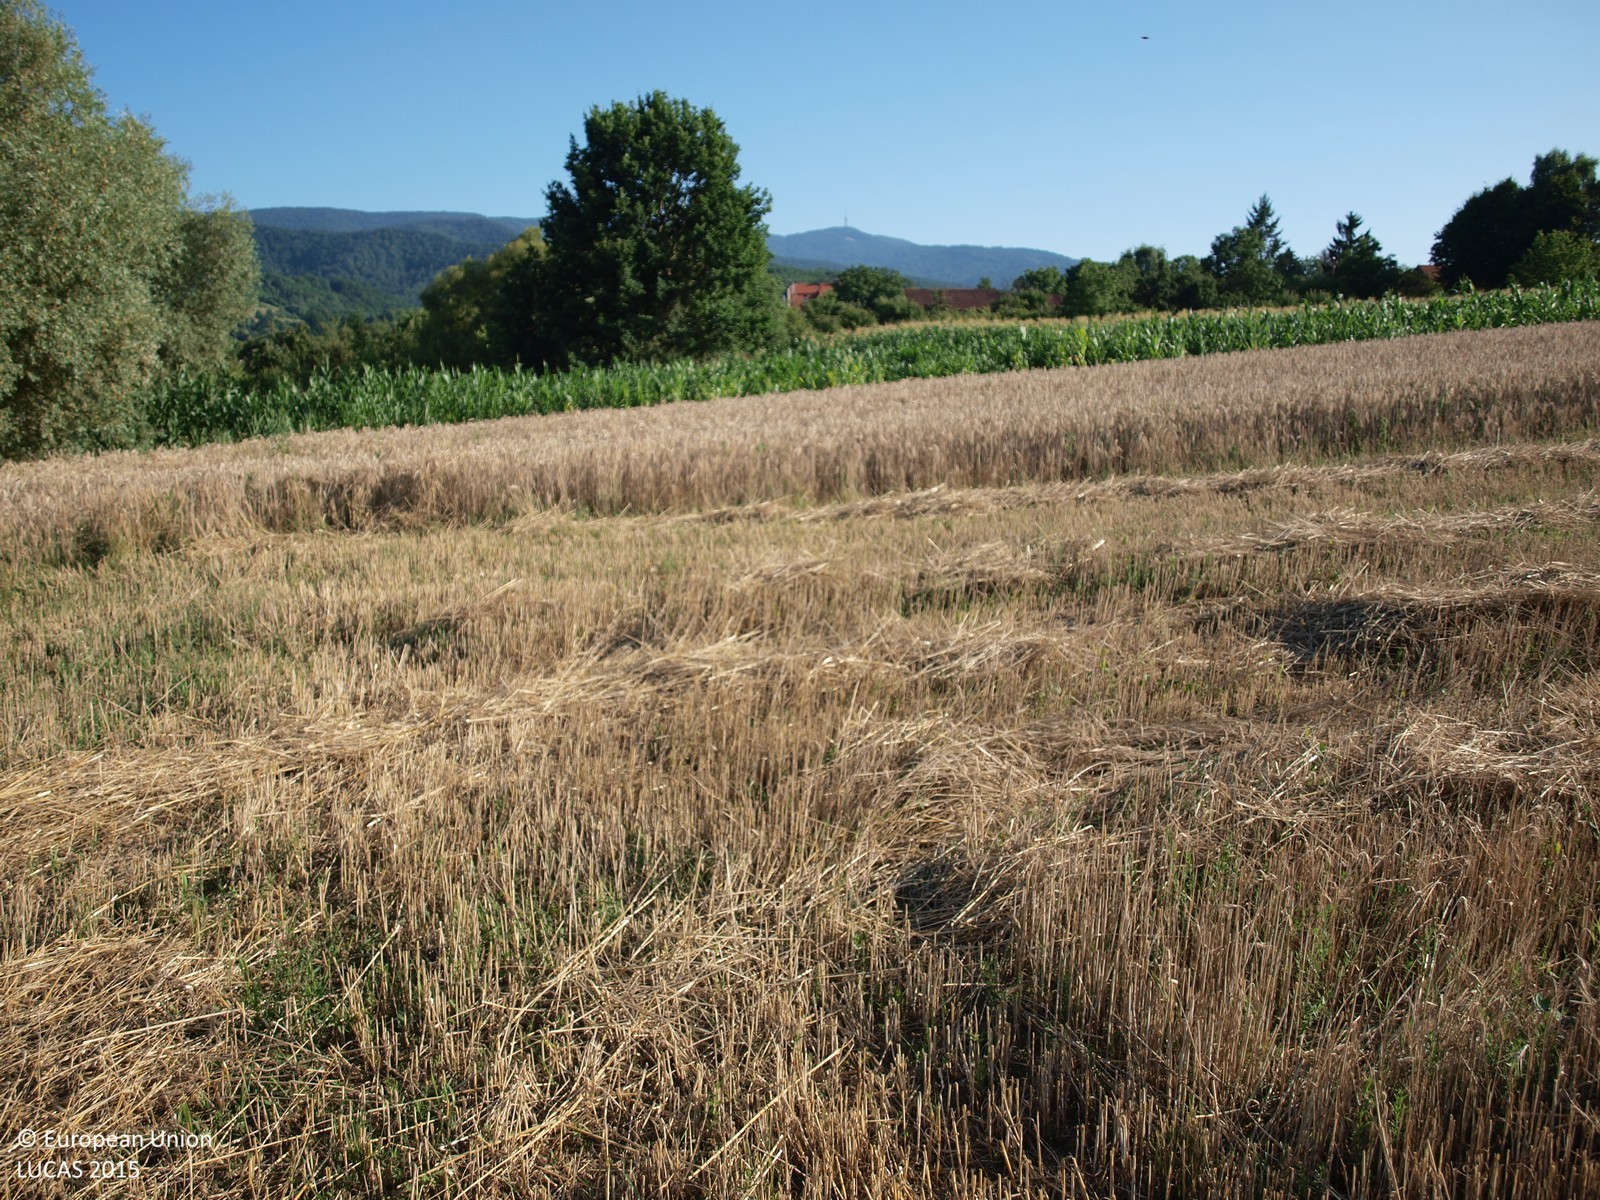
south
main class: Cropland
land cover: Barley
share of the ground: > 75 %
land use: Agriculture (excluding fallow land and kitchen gardens)
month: July
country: HR
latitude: 45.9675
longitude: 15.9733
